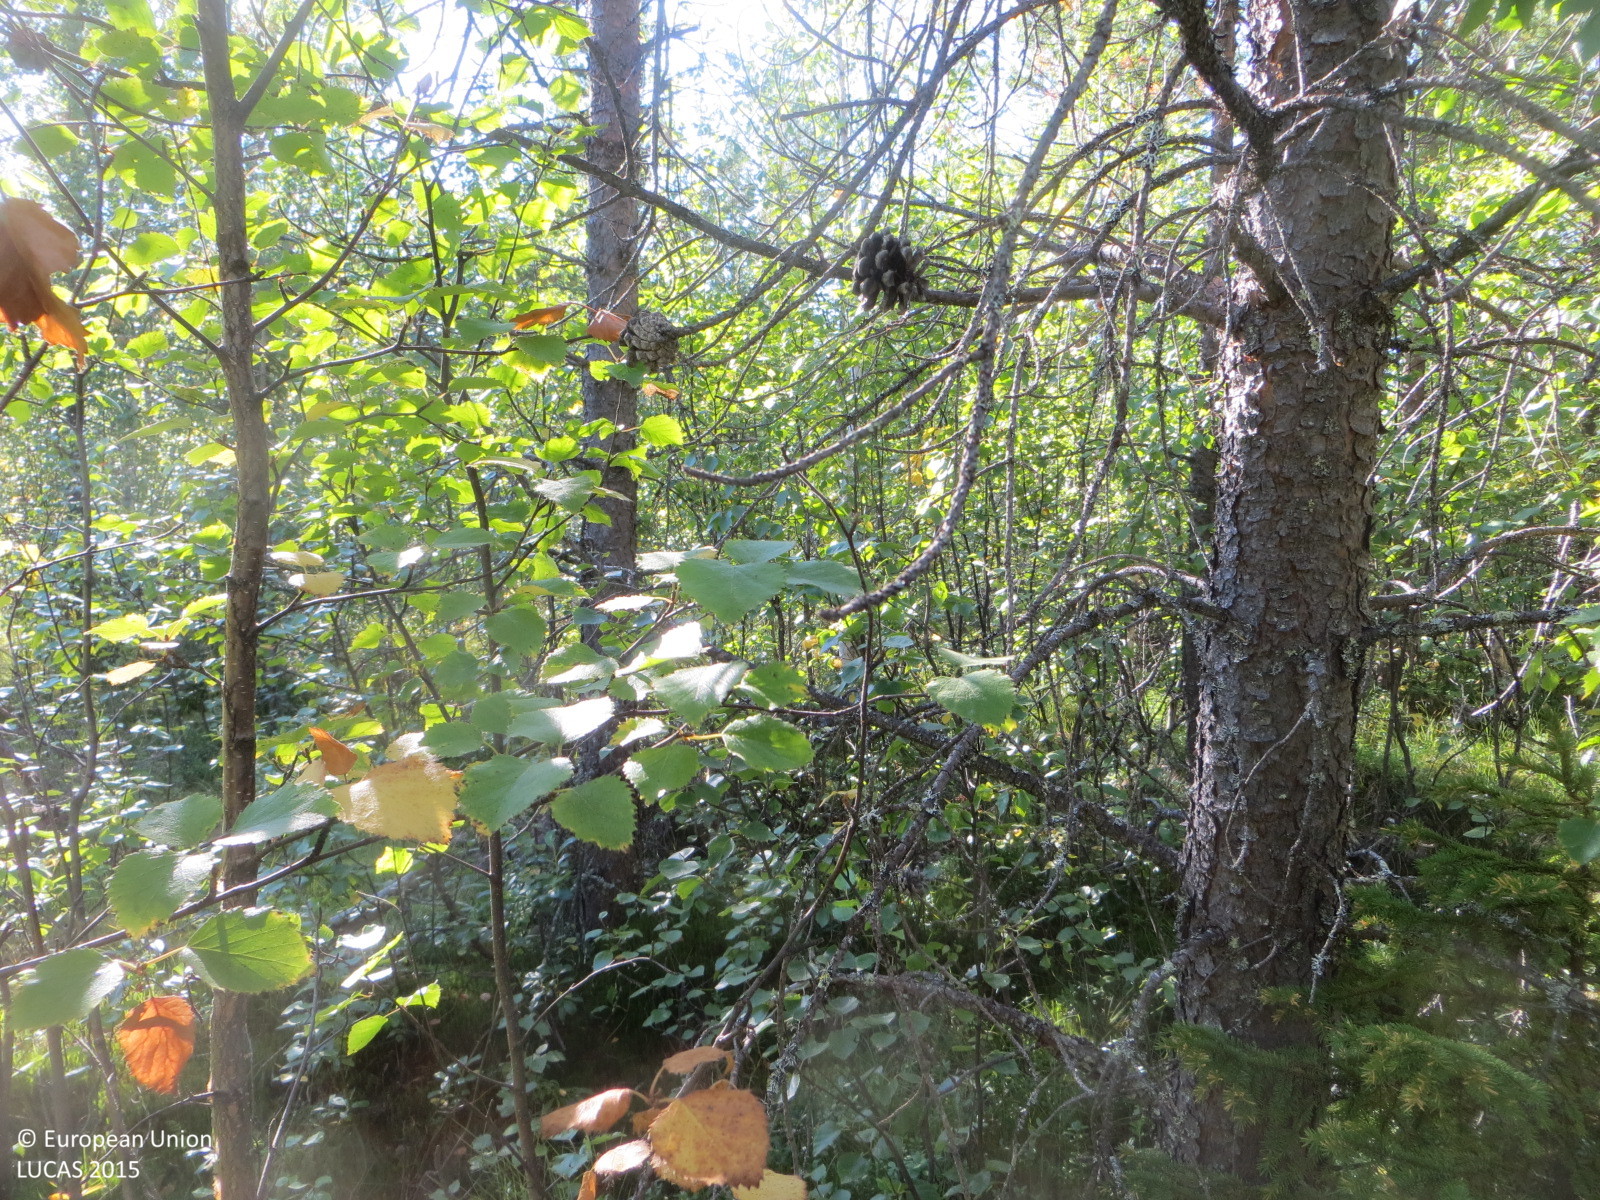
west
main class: Woodland
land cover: Pine dominated mixed woodland
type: boreal forest
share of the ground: > 75 %
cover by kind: broadleaved forest trees 50 %, coniferous forest trees 35 %, shrubs 15 %
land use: Forestry
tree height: > 5 m
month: August
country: FI
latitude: 67.2544
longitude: 24.0491
